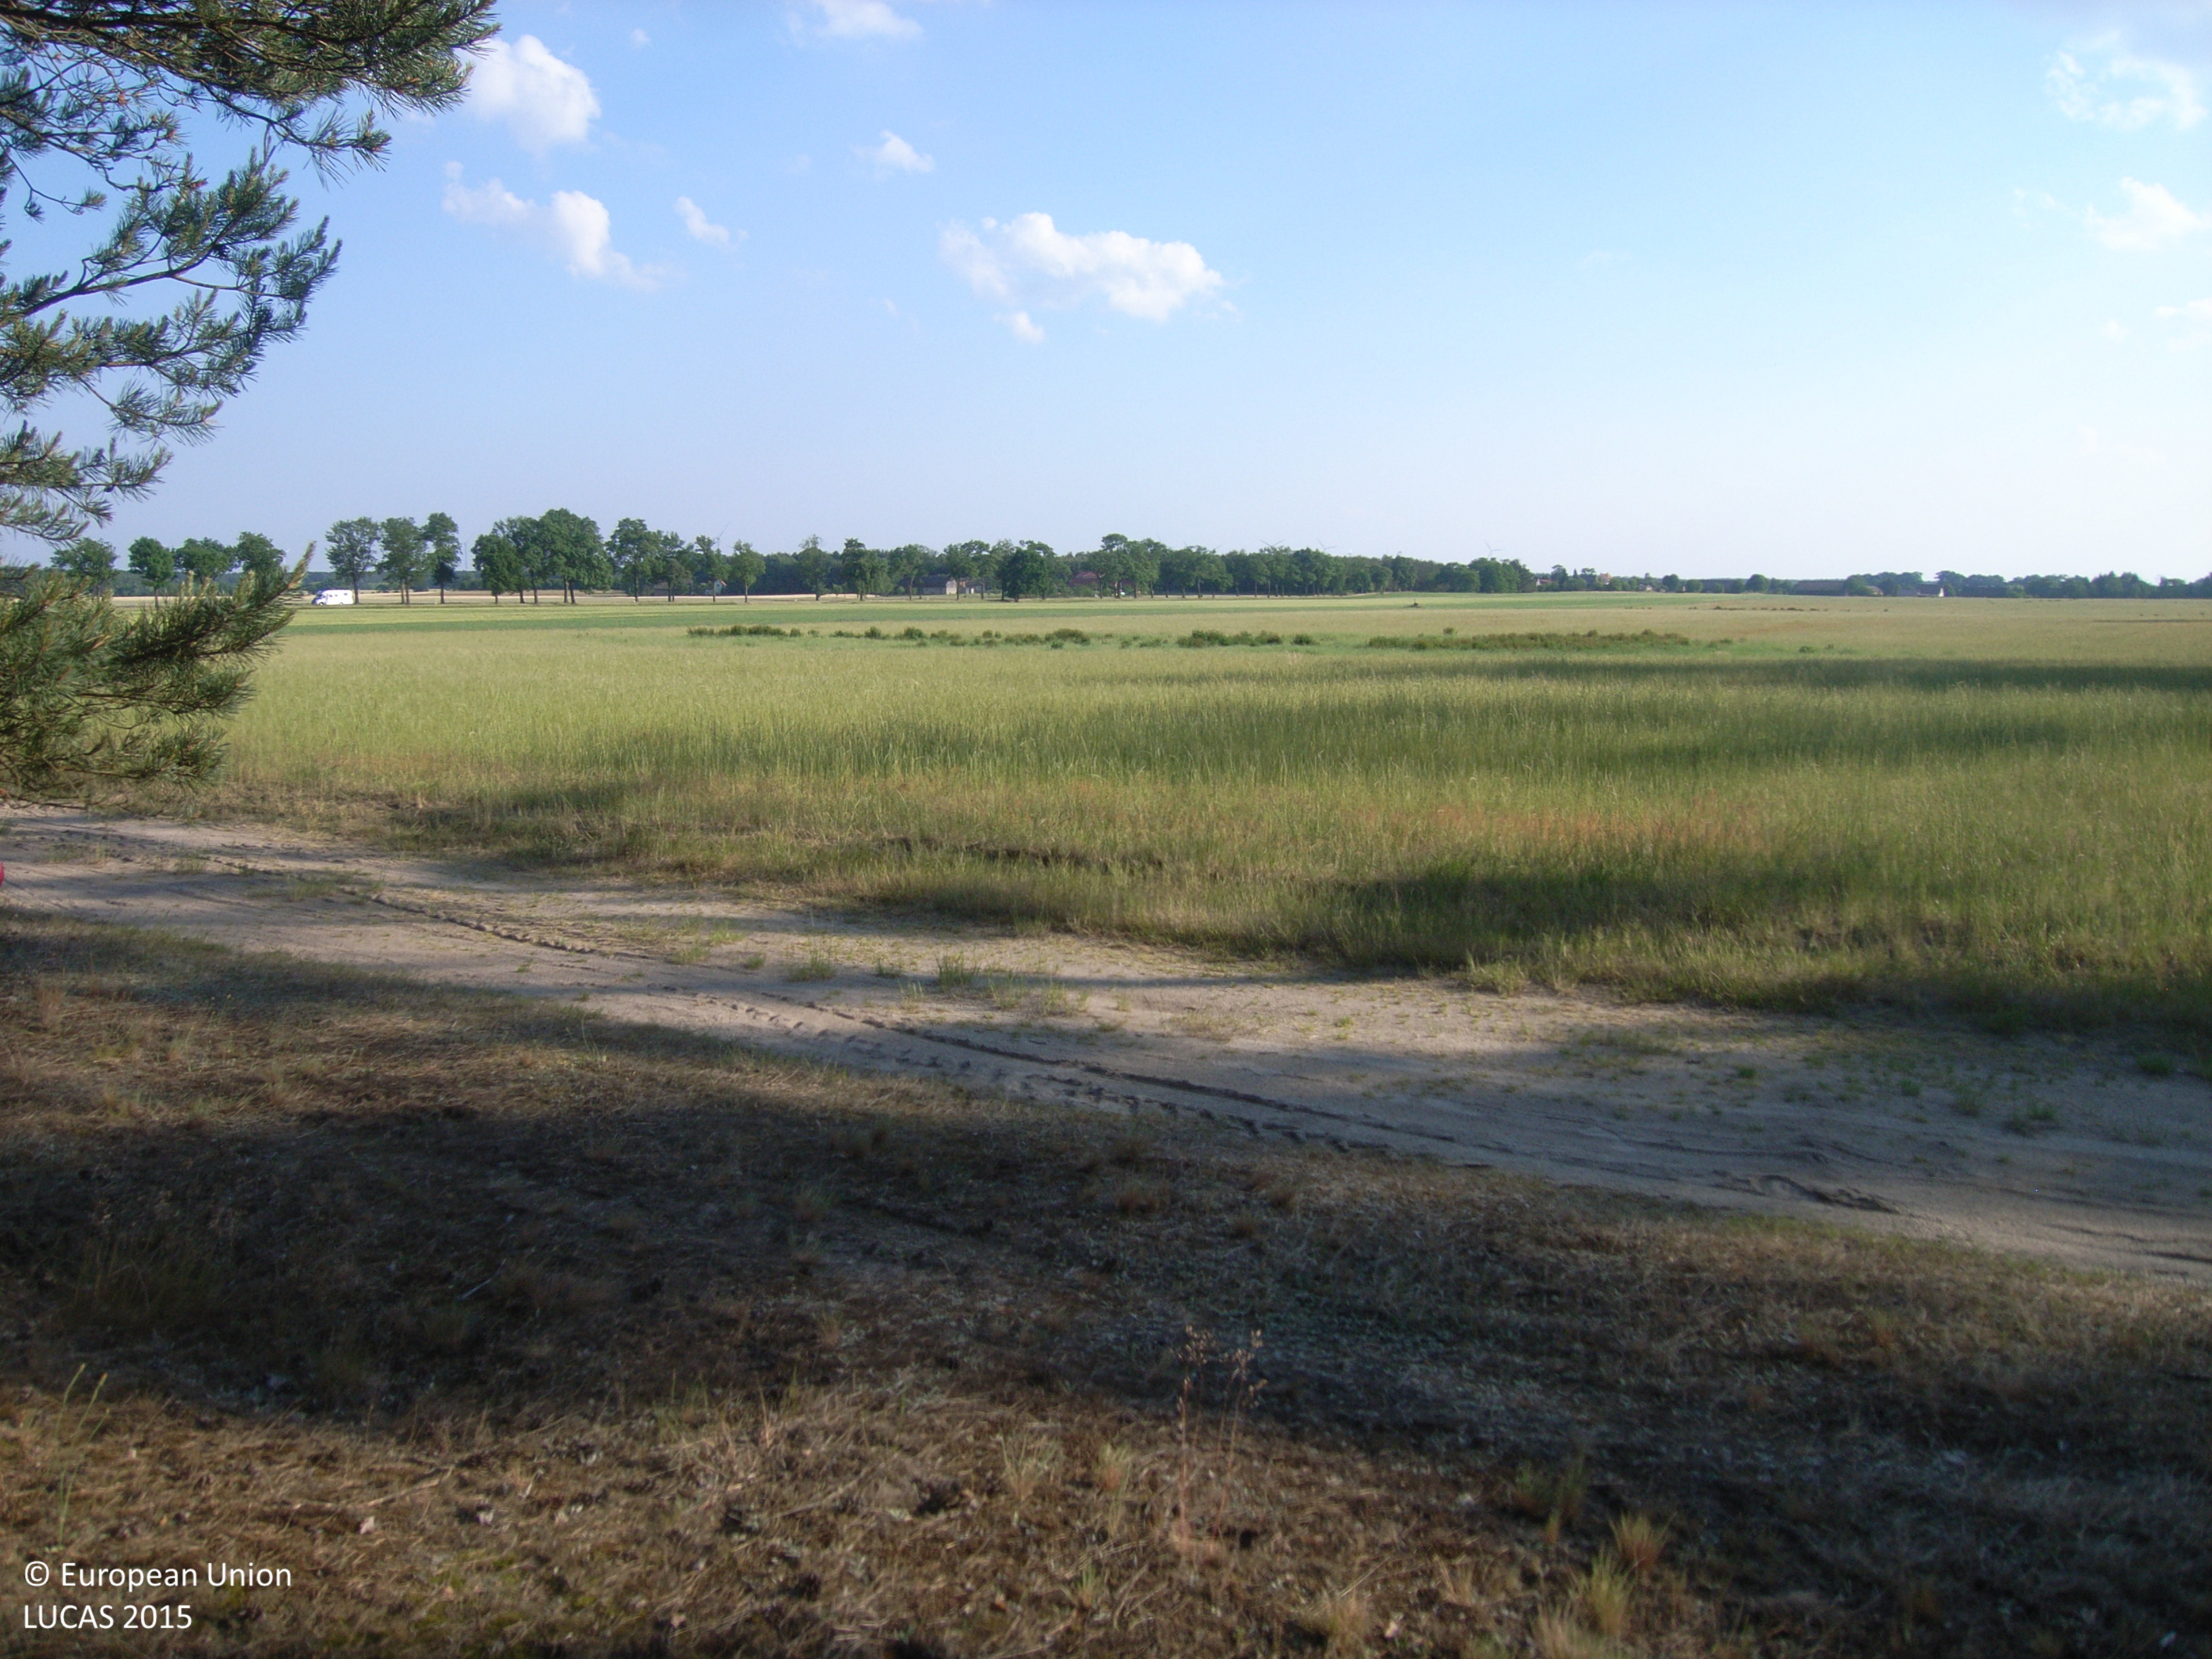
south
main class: Woodland
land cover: Pine dominated coniferous woodland
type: hemiboreal forest and nemoral coniferous forest and mixed broadleaved-coniferous forest
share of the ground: > 75 %
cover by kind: coniferous forest trees 100 %
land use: Forestry
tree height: > 5 m
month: June
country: DE
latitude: 52.0368
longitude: 14.0974
